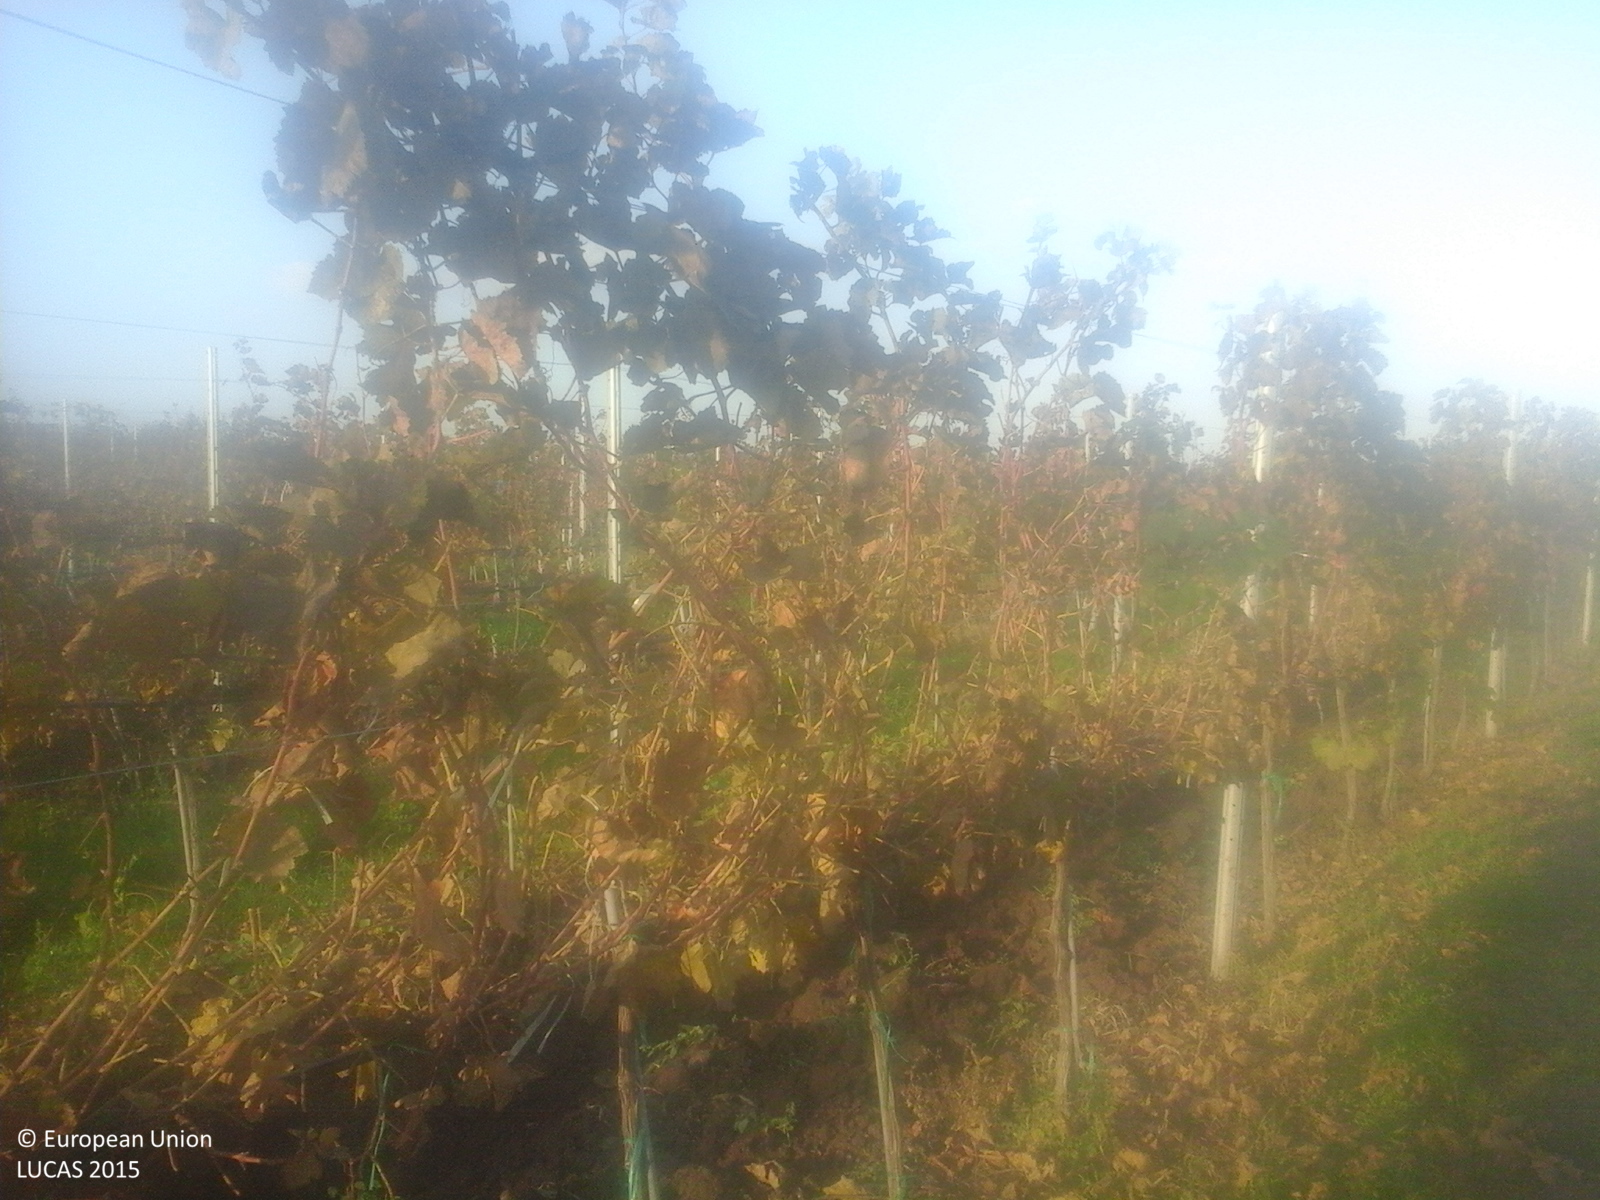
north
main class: Cropland
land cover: Vineyards
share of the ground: > 75 %
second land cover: Other bare soil
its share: > 75 %
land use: Agriculture (excluding fallow land and kitchen gardens)
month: October
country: RO
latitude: 45.3849
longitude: 26.9833
